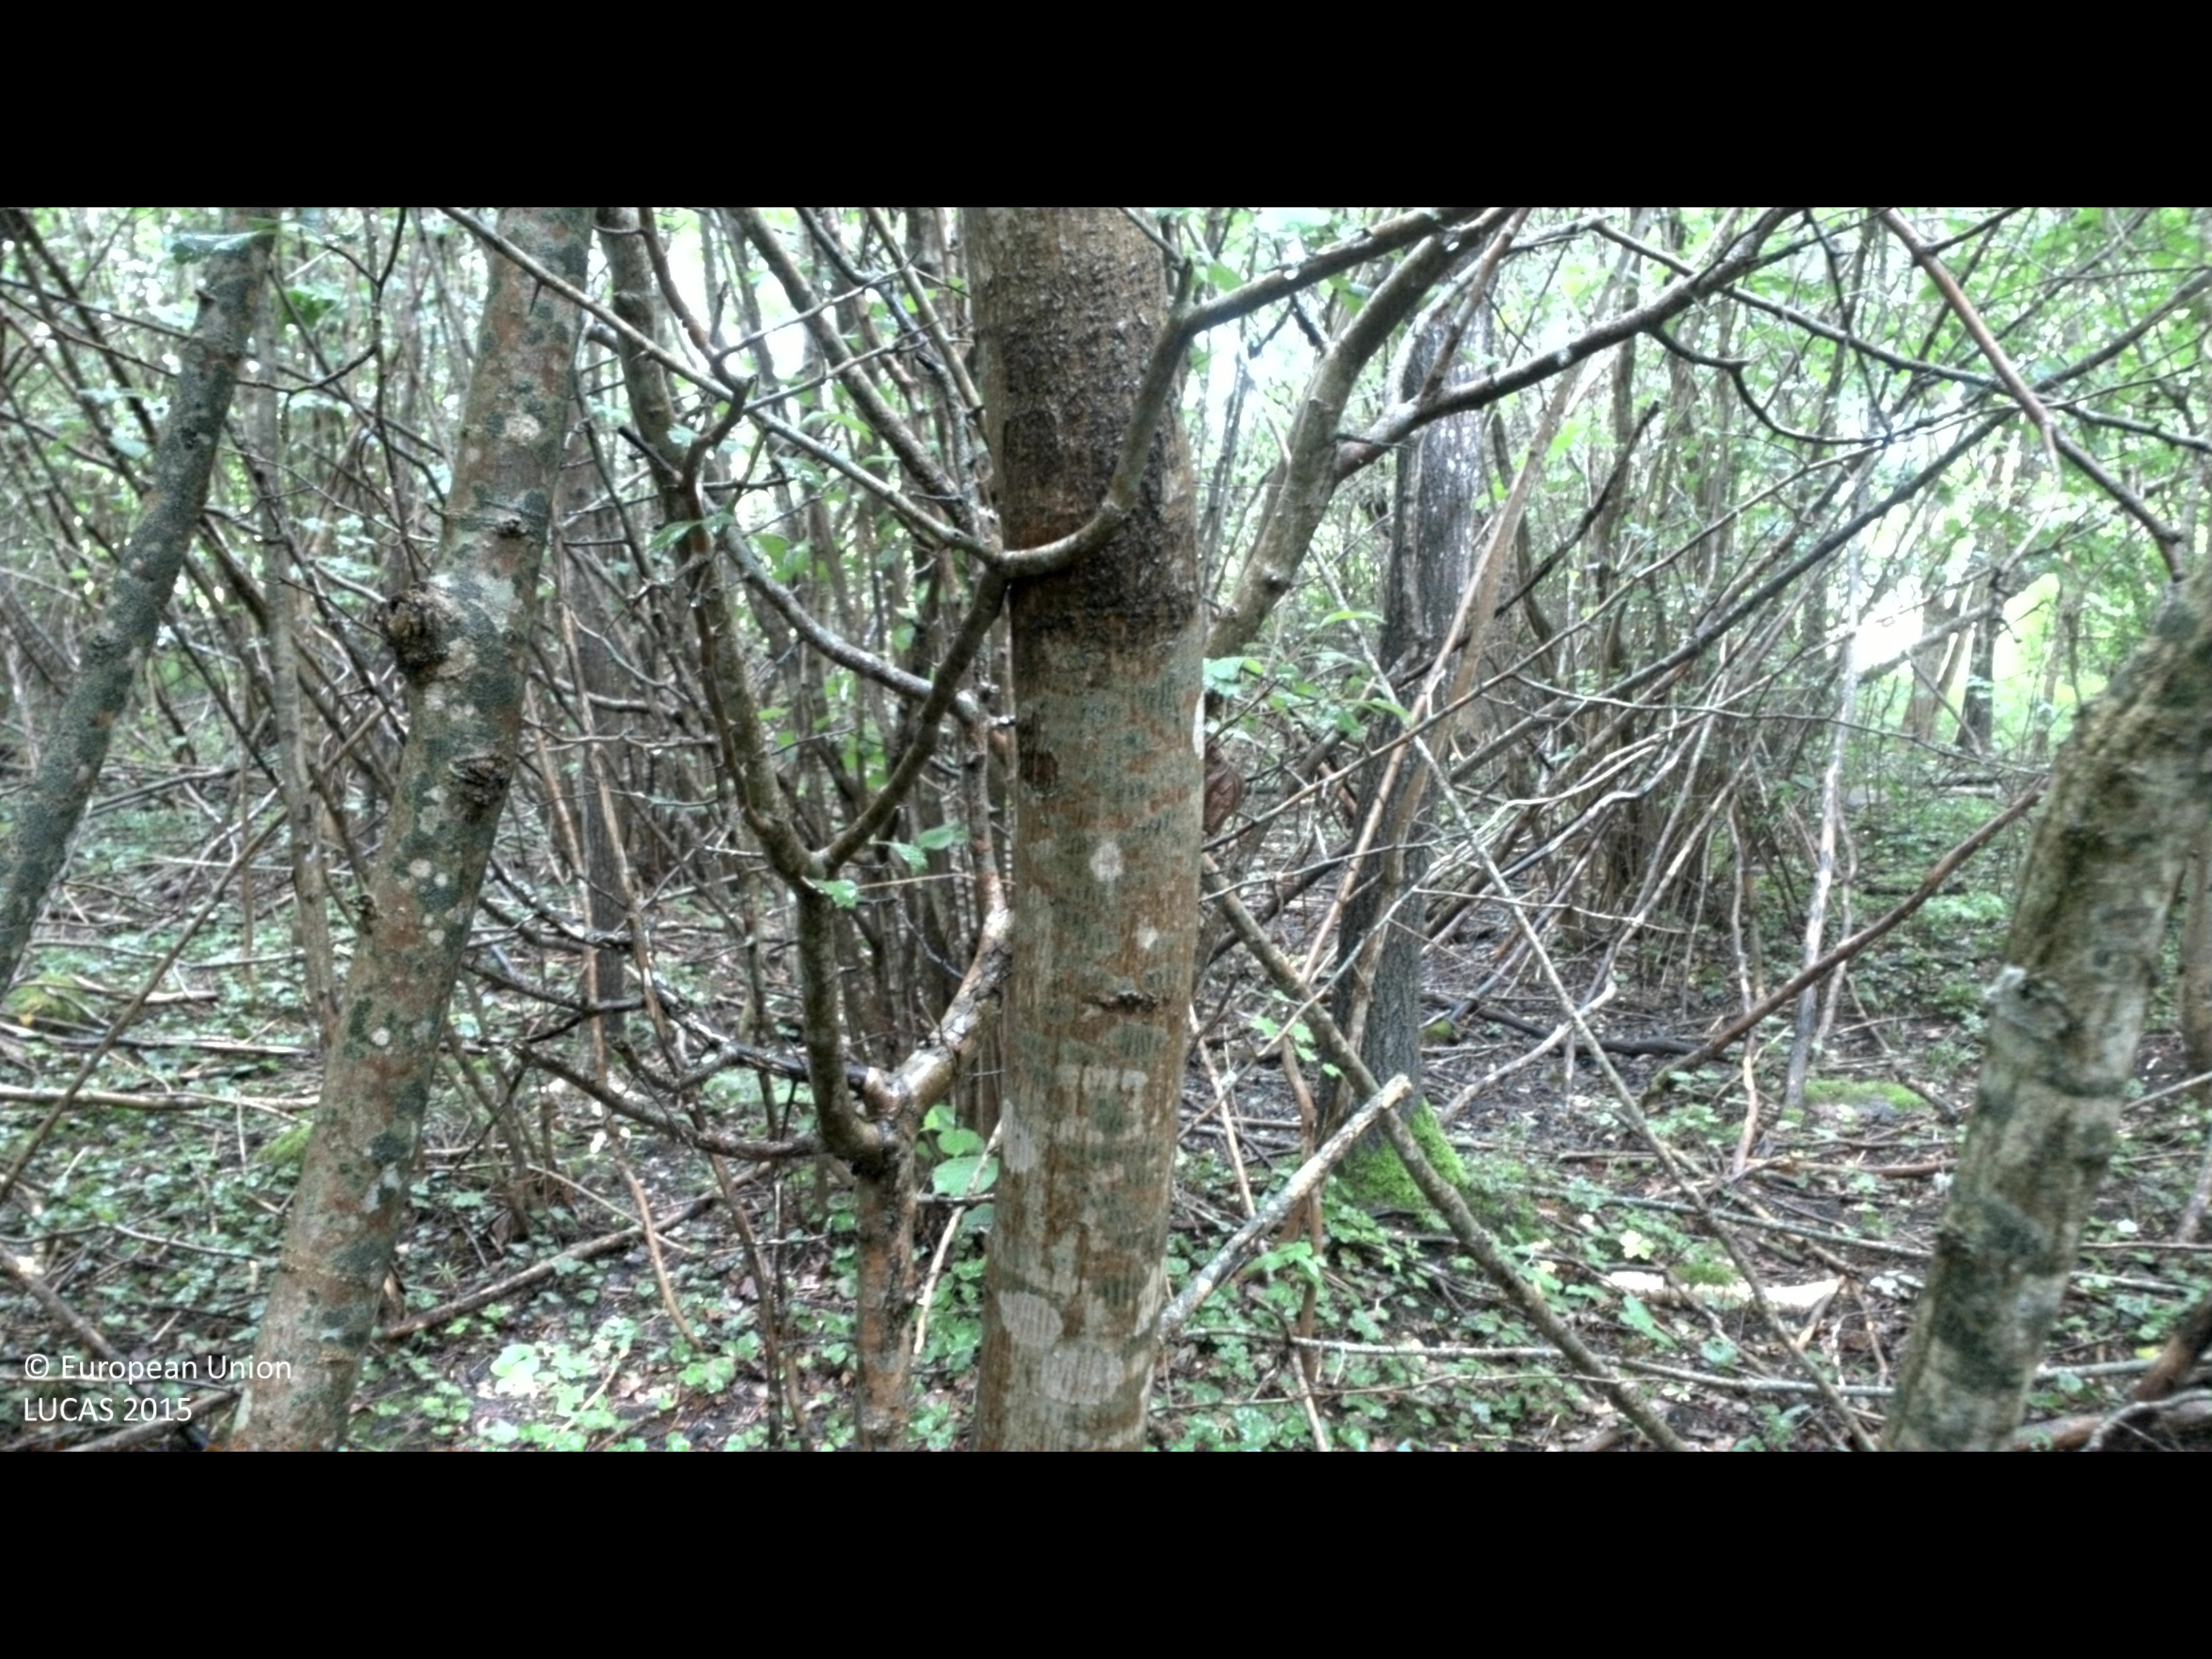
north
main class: Woodland
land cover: Broadleaved woodland
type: mesophytic deciduous forest
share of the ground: 50 - 75 %
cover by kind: broadleaved forest trees 70 %, shrubs 30 %
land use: Semi-natural and natural areas not in use
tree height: > 5 m
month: July
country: SE
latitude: 56.6166
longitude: 16.5361
